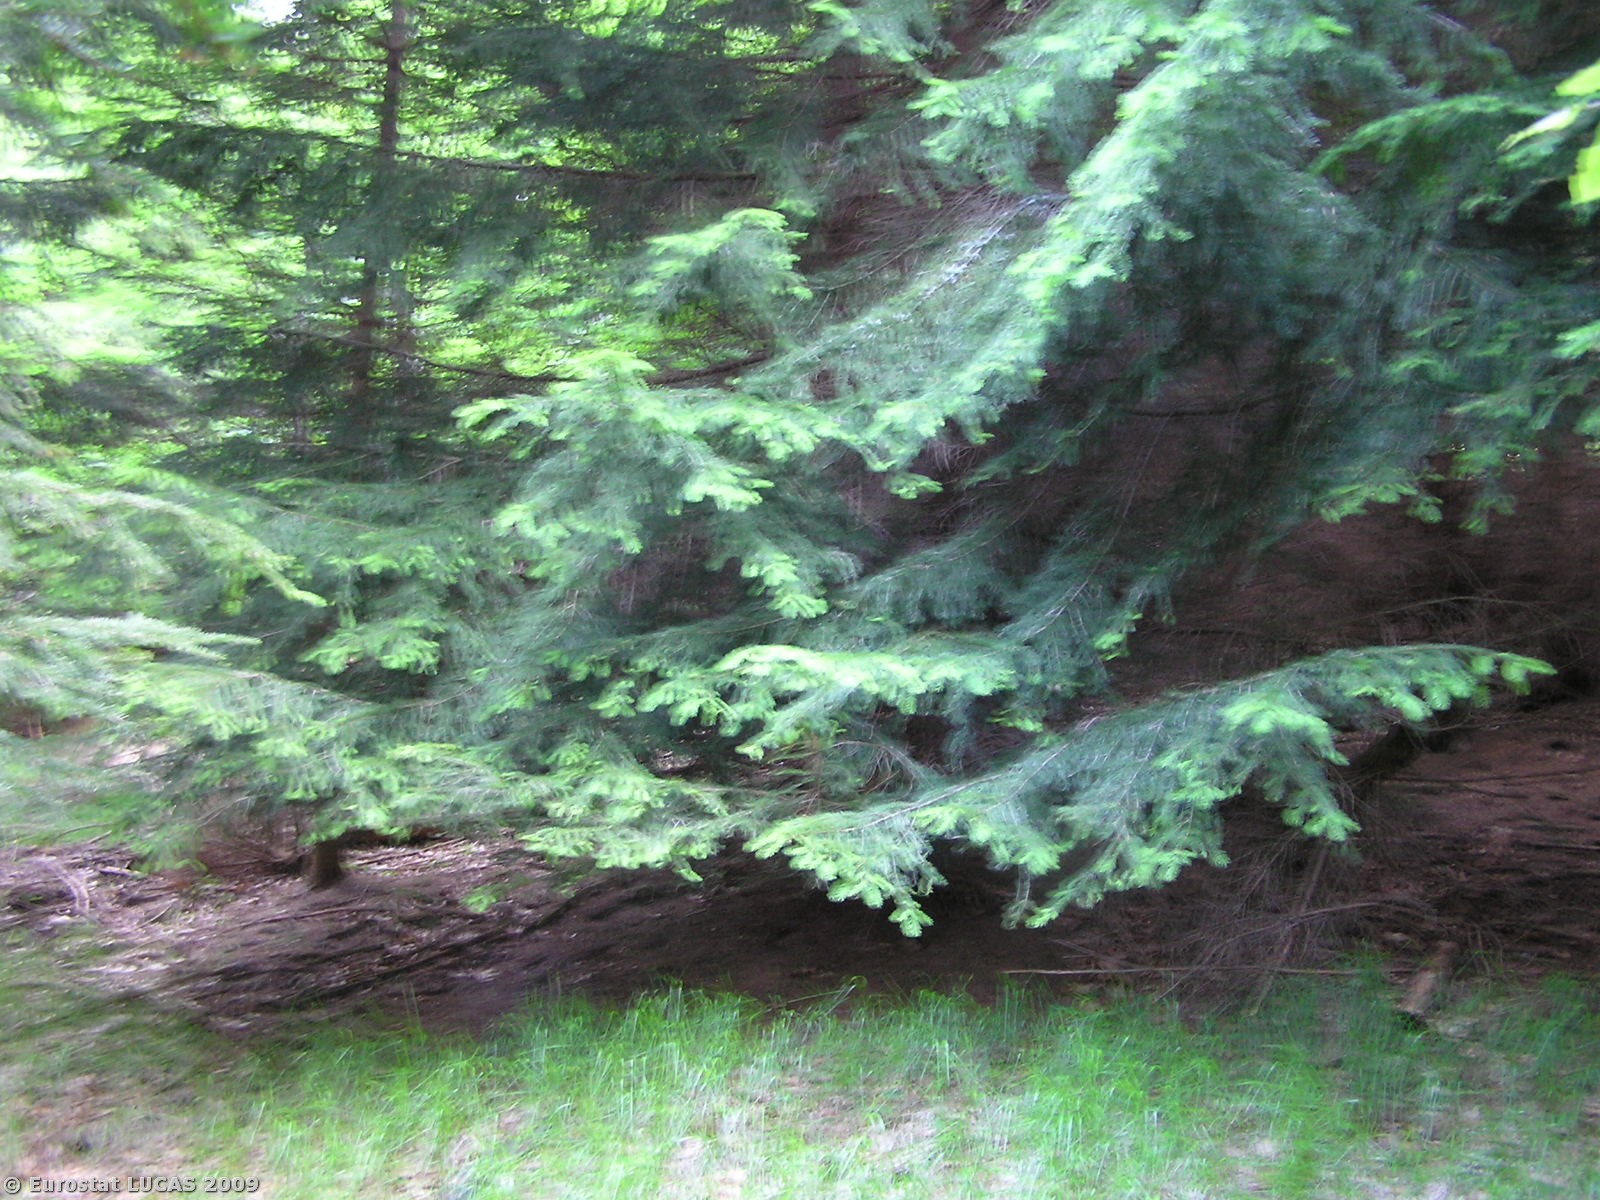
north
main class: Woodland
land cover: Mixed woodland
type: hemiboreal forest and nemoral coniferous forest and mixed broadleaved-coniferous forest
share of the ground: > 75 %
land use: Forestry
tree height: > 5 m
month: July
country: CZ
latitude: 50.0431
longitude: 17.2582
